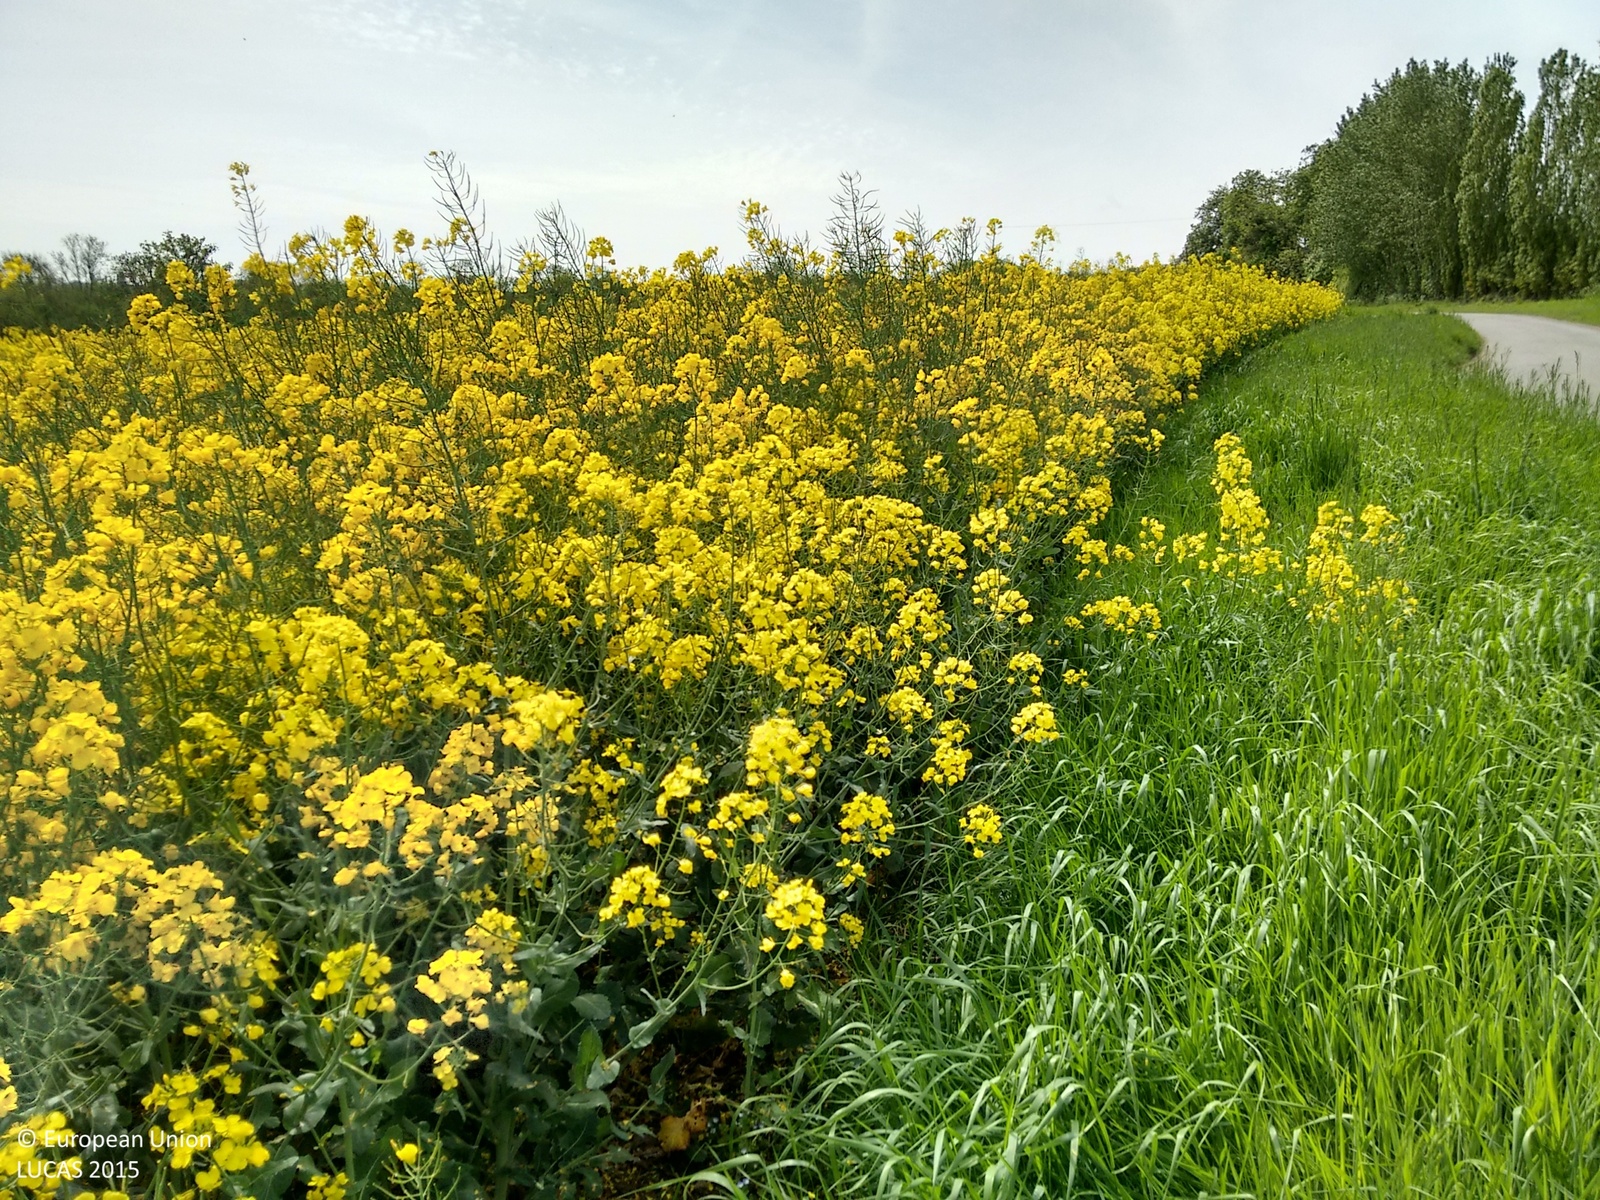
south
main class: Cropland
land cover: Rape and turnip rape
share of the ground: > 75 %
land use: Agriculture (excluding fallow land and kitchen gardens)
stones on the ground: < 10 %
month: May
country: GB
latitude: 51.1836
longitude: 0.3135
